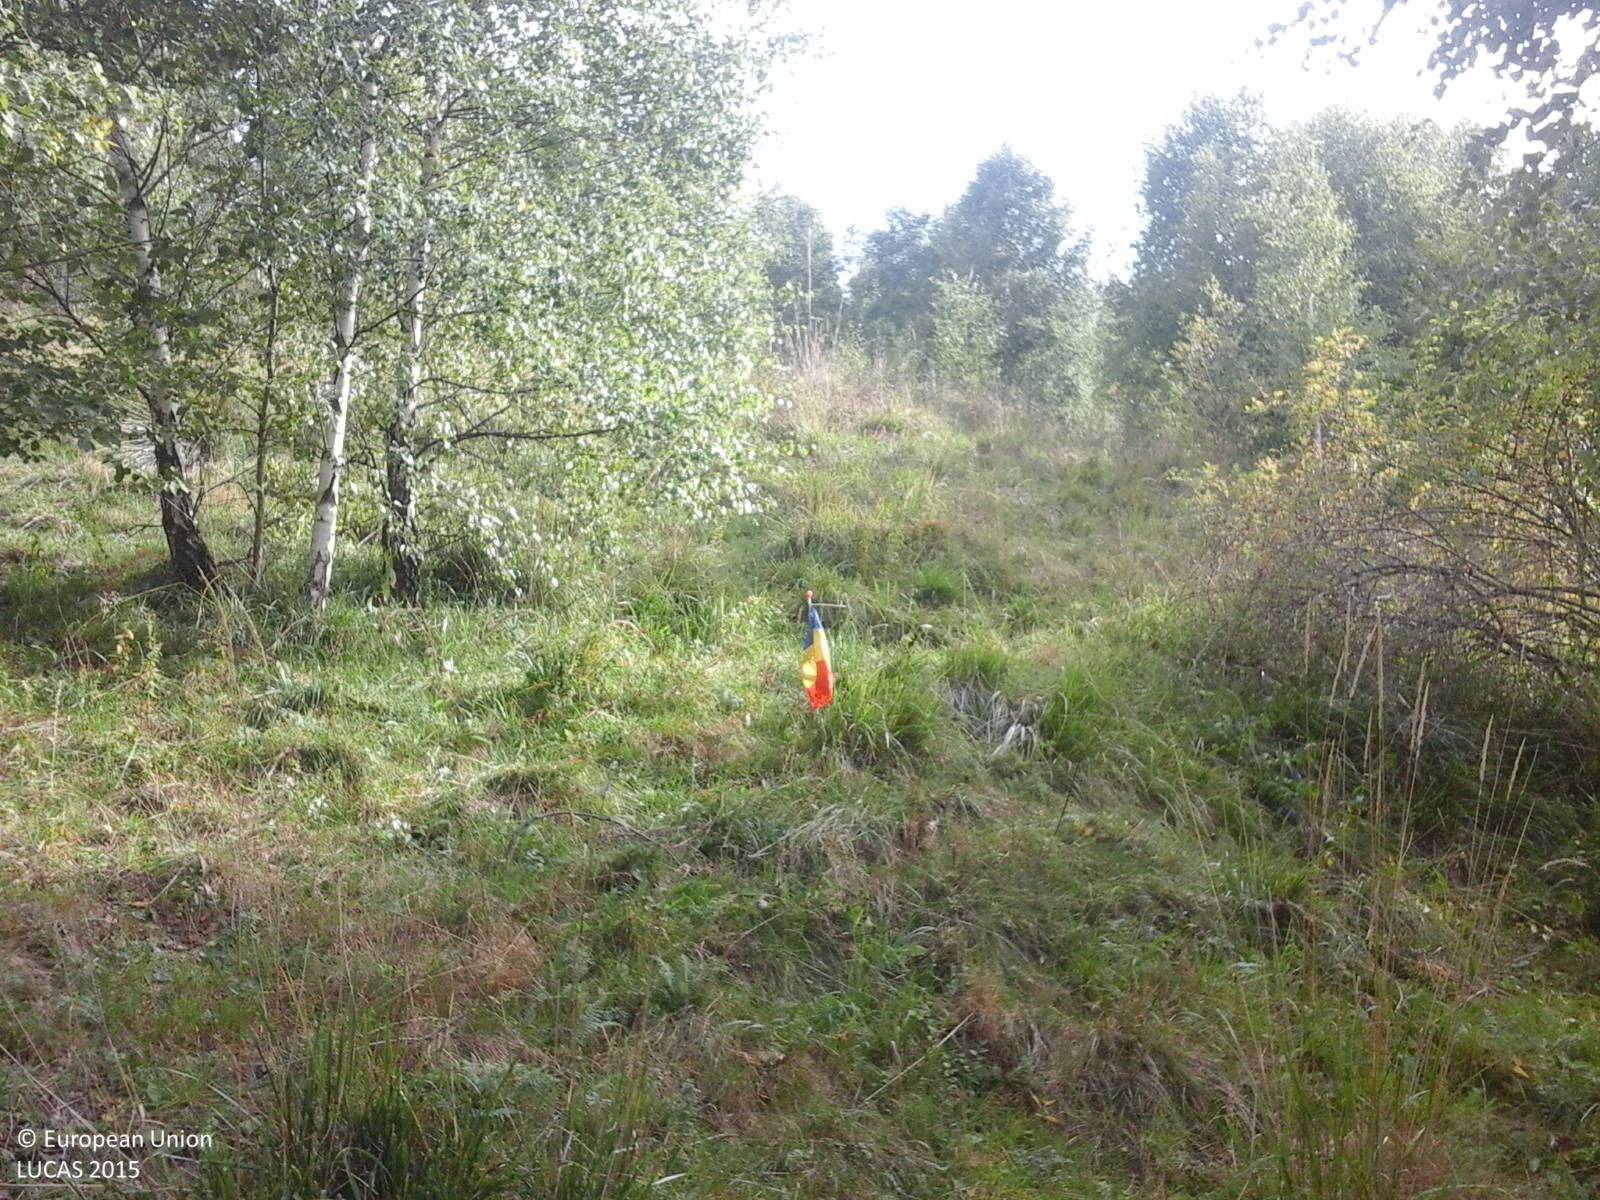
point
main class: Woodland
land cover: Broadleaved woodland
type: acidophilous oak and oak-birch forest
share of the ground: > 75 %
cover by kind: broadleaved forest trees 100 %
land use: Forestry
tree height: > 5 m
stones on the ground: < 10 %
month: September
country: RO
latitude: 46.6794
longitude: 23.3353
